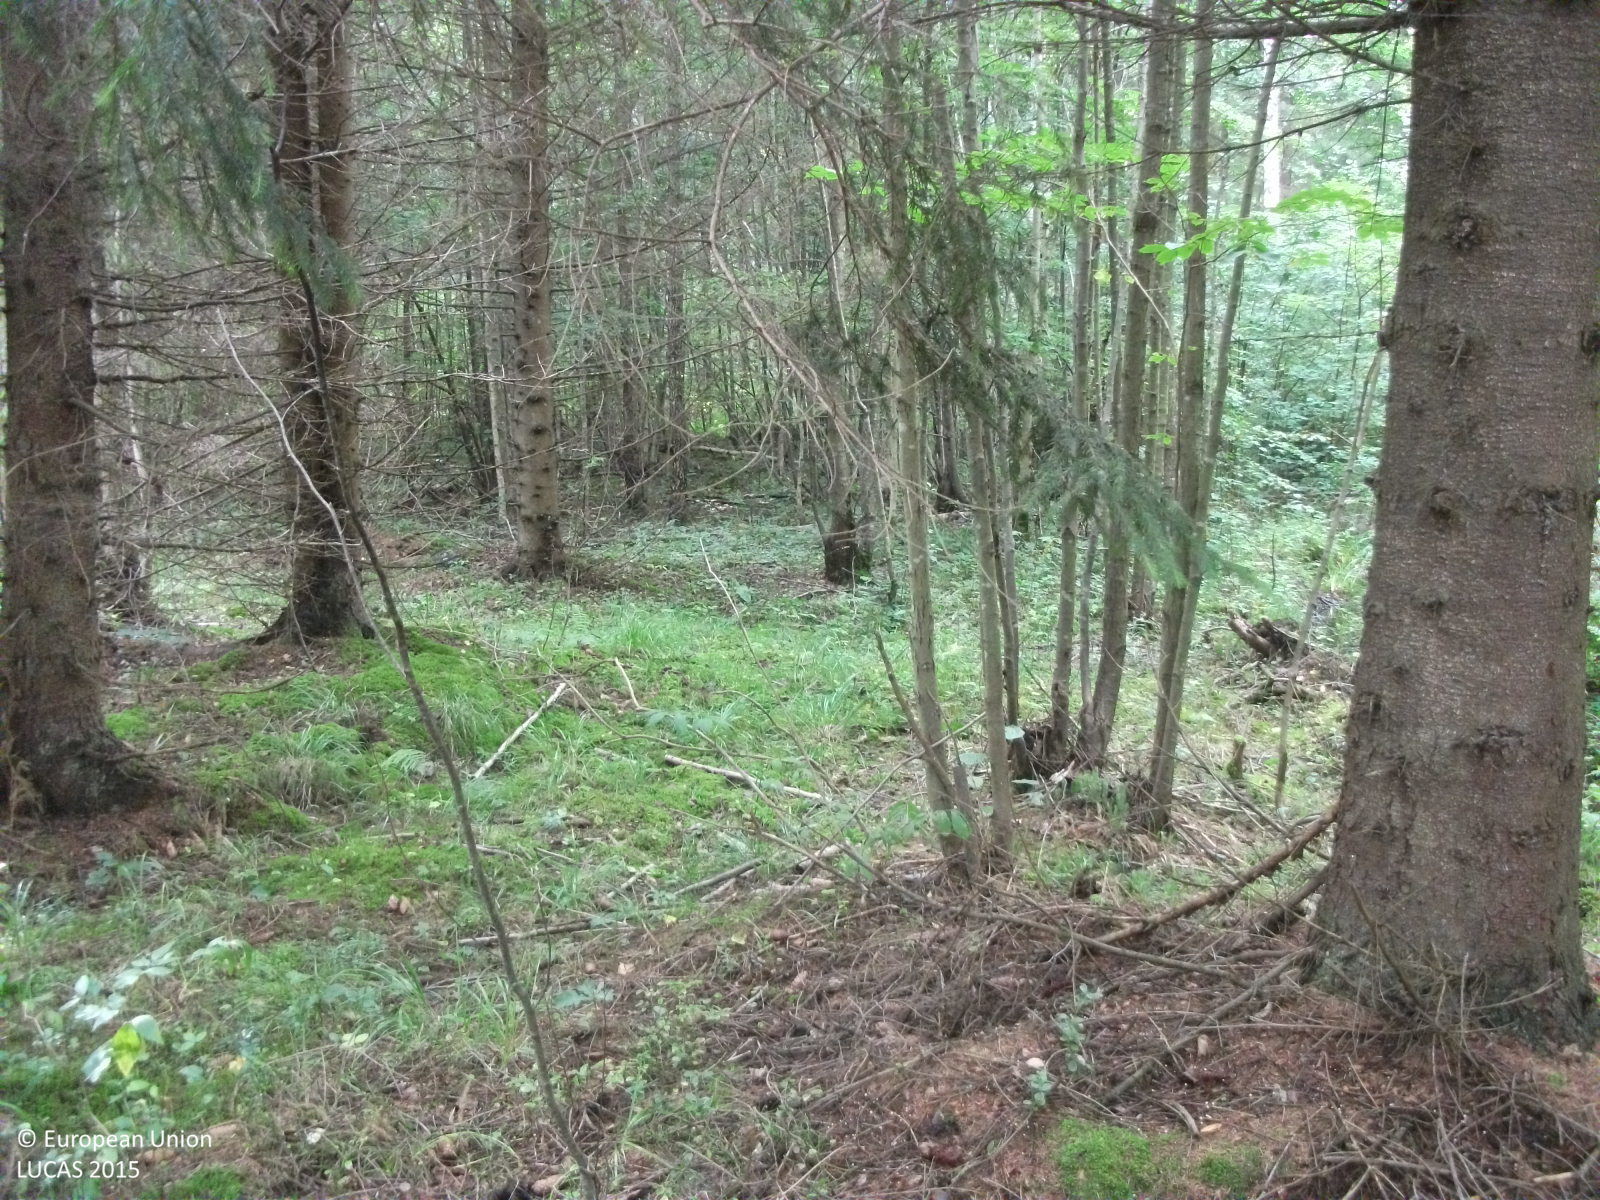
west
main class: Woodland
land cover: Spruce dominated coniferous woodland
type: hemiboreal forest and nemoral coniferous forest and mixed broadleaved-coniferous forest
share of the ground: > 75 %
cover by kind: coniferous forest trees 80 %, lichens and mosses 10 %, shrubs 5 %, herbaceous plants 5 %
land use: Forestry
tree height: > 5 m
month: September
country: LV
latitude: 57.5823
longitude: 24.4221
